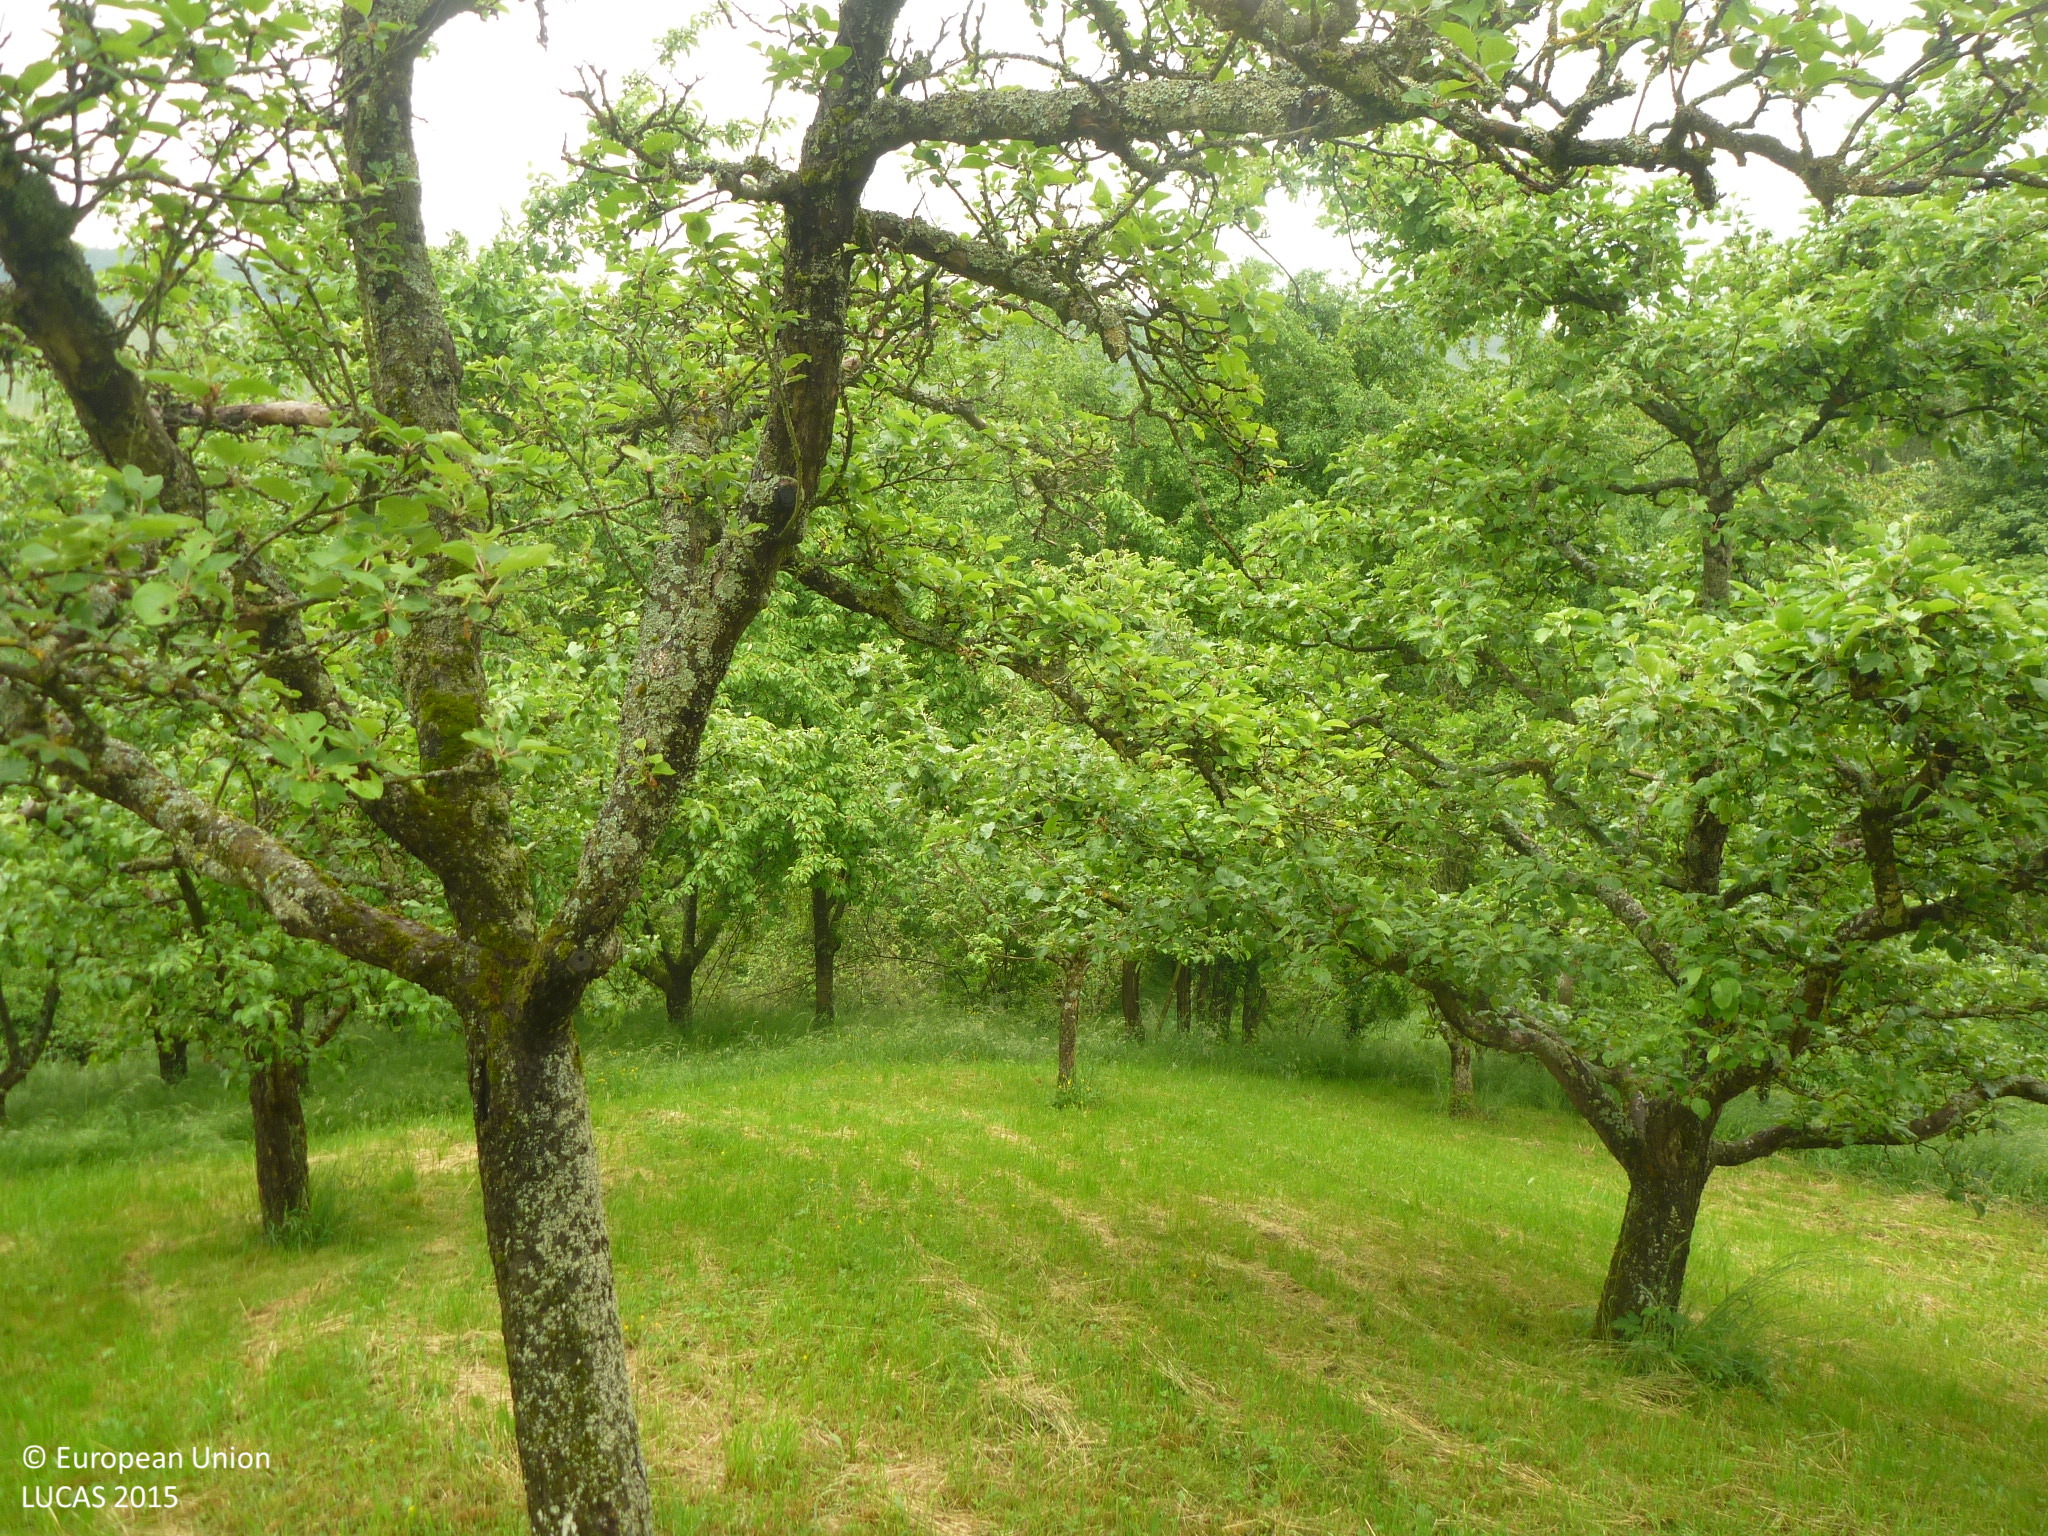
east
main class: Cropland
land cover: Apple fruit
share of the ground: 50 - 75 %
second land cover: Grassland without tree/shrub cover
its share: > 75 %
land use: Agriculture (excluding fallow land and kitchen gardens)
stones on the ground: < 10 %
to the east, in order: Apple fruit; Grassland without tree/shrub cover; Cherry fruit; Apple fruit; Tracks; Apple fruit; Grassland with sparse tree/shrub cover; Rivers and streams; Broadleaved woodland; Grassland without tree/shrub cover; Apple fruit; Grassland without tree/shrub cover; Electric lines; Grassland with sparse tree/shrub cover
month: May
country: DE
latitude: 48.7793
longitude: 9.3335
